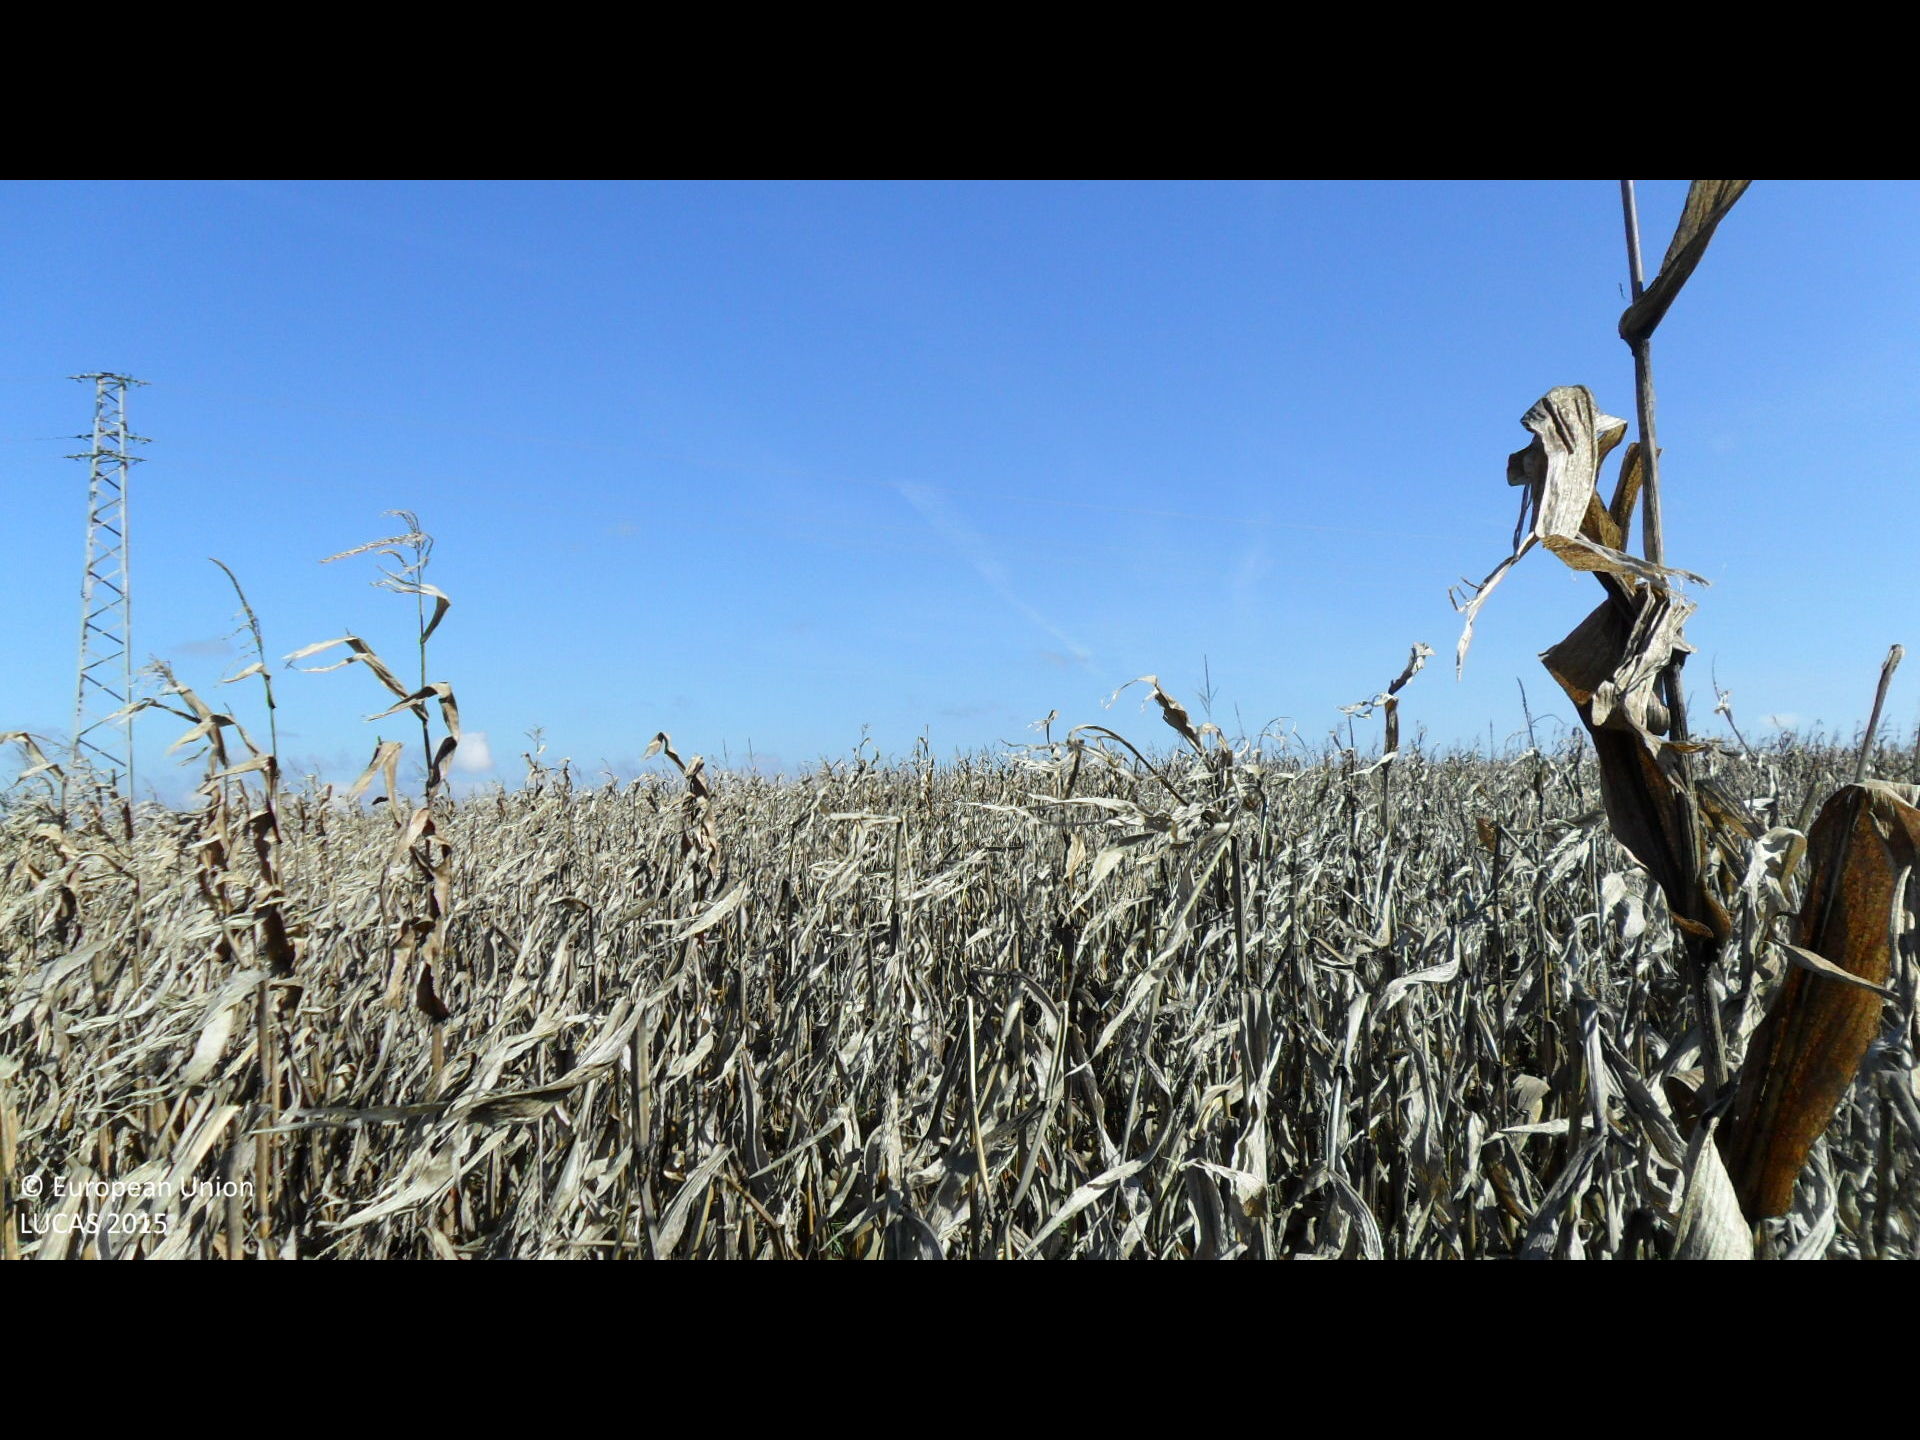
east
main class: Cropland
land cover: Maize
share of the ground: > 75 %
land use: Agriculture (excluding fallow land and kitchen gardens)
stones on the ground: < 10 %
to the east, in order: Maize
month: October
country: BG
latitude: 43.2015
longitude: 26.2795
